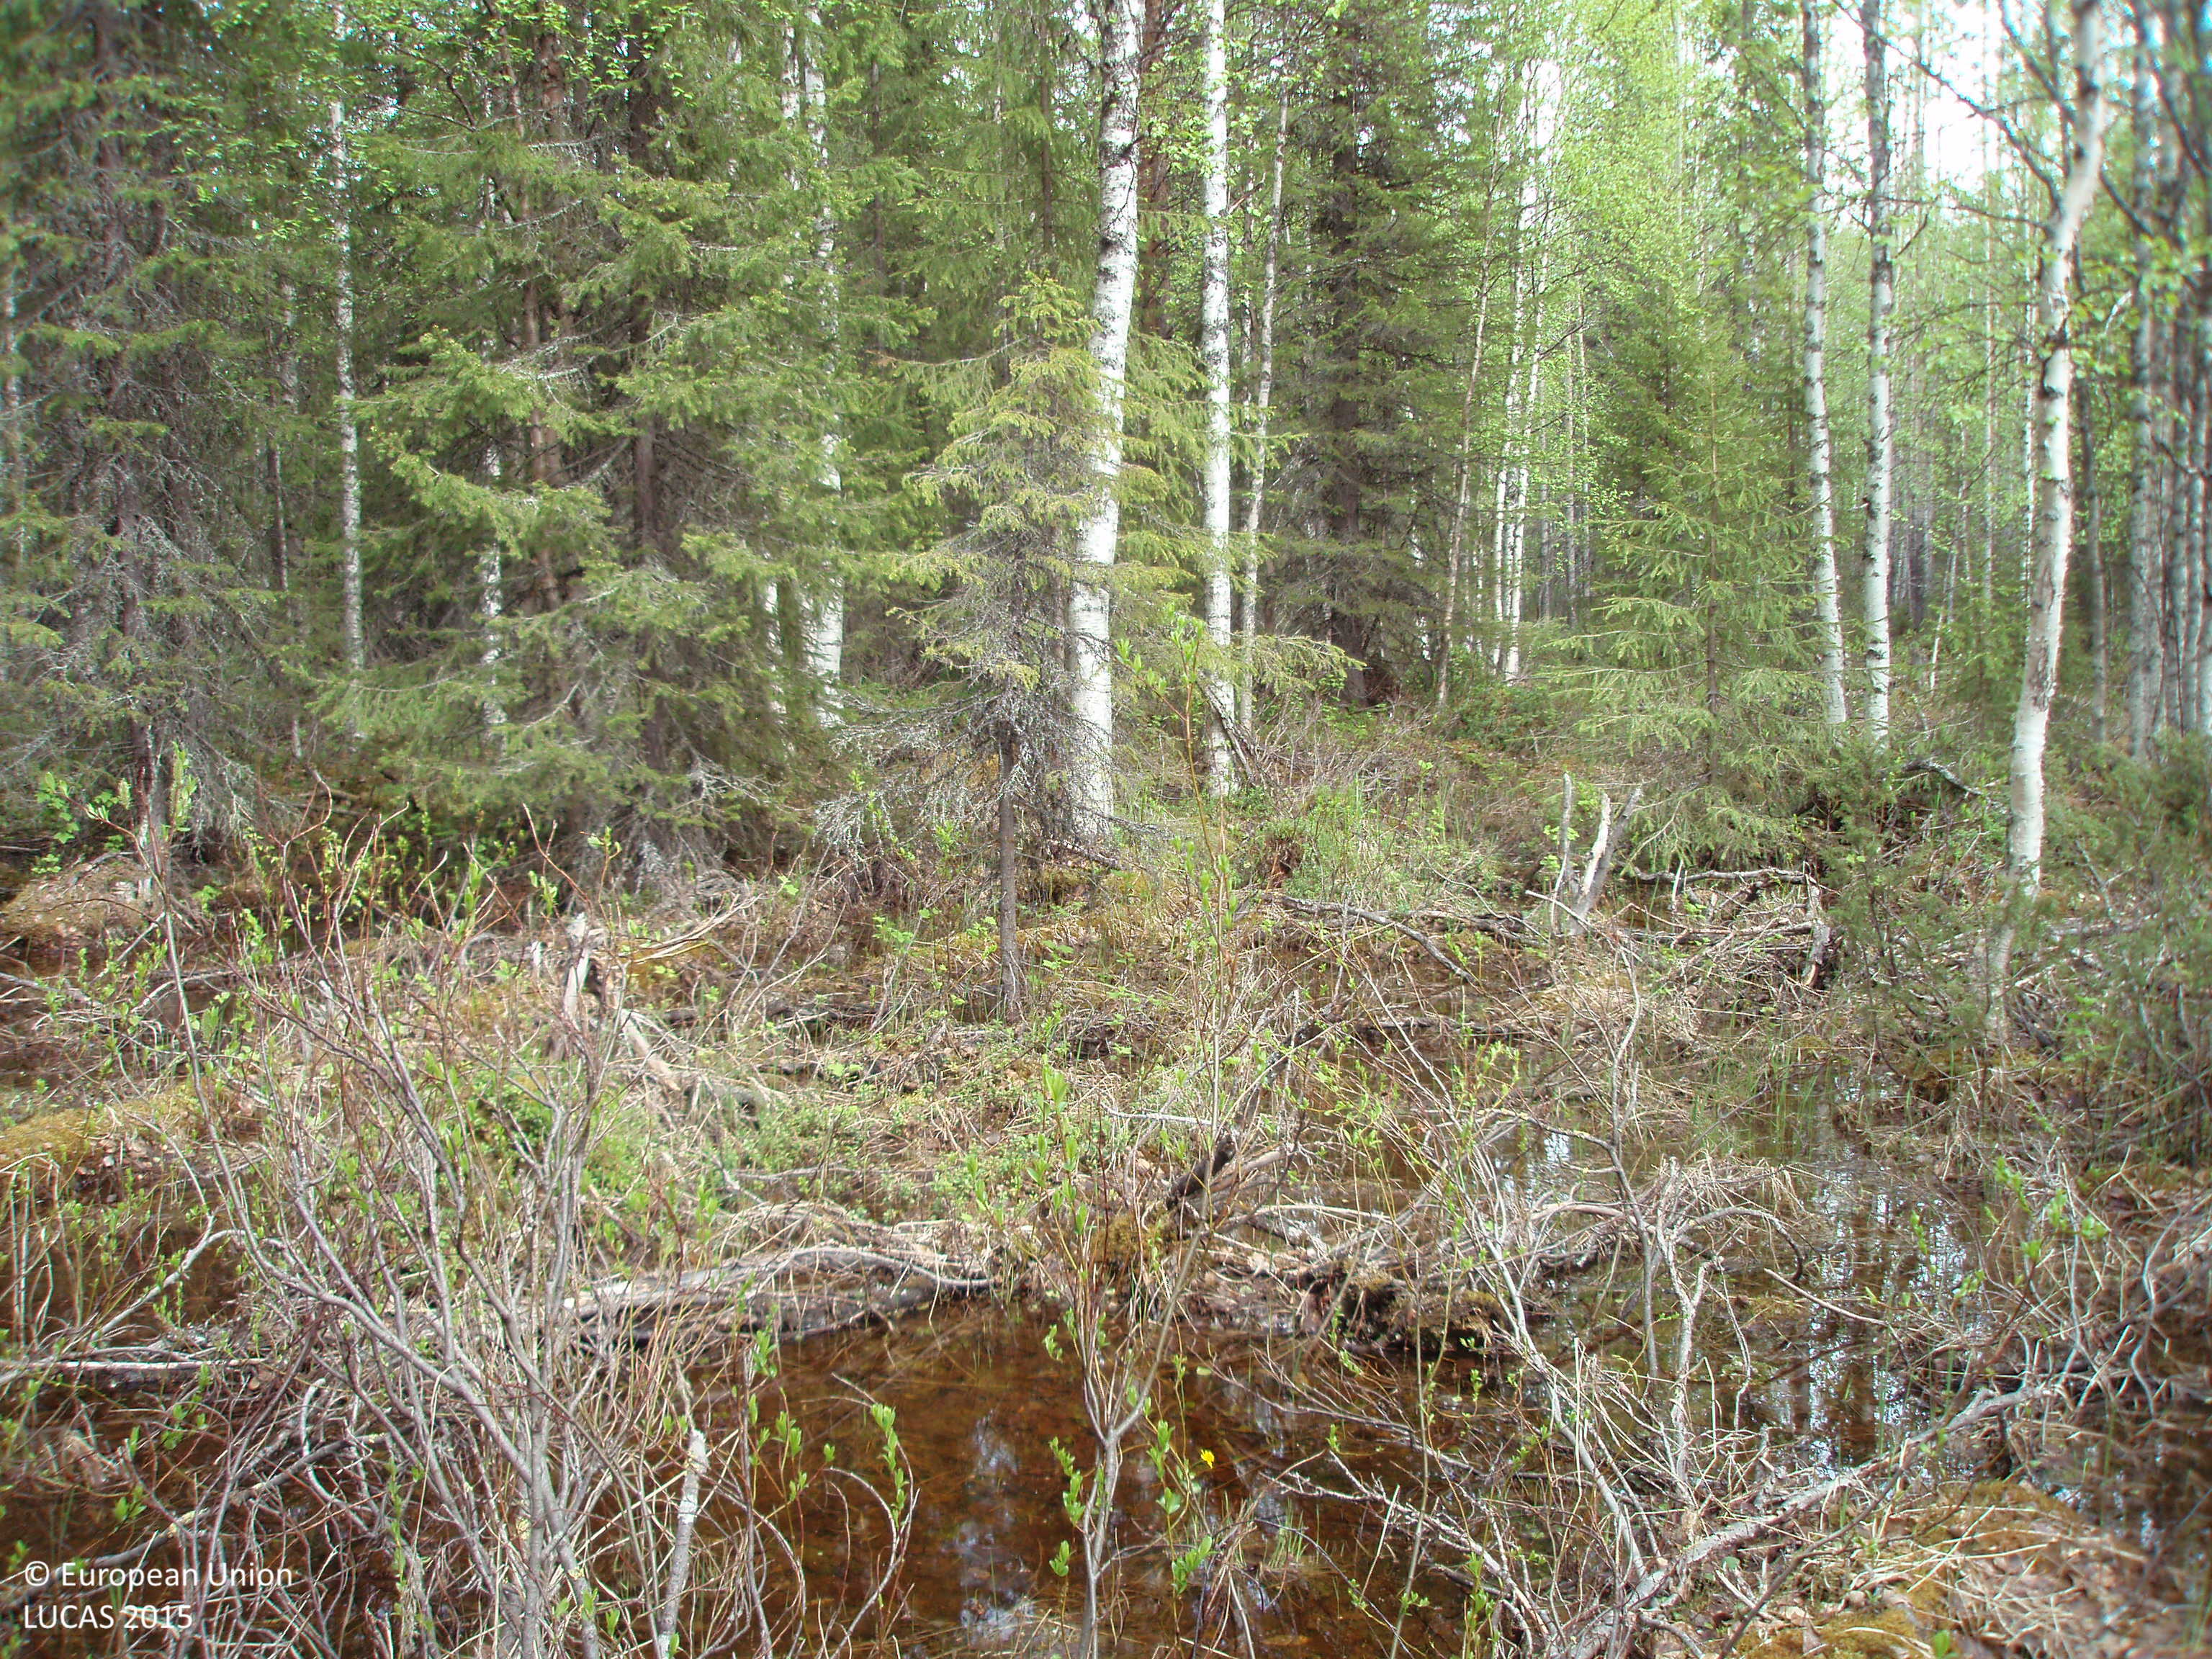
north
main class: Woodland
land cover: Other mixed woodland
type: boreal forest
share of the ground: > 75 %
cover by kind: coniferous forest trees 40 %, broadleaved forest trees 40 %, shrubs 10 %, herbaceous plants 10 %
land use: Forestry
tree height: > 5 m
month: June
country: FI
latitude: 67.1809
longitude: 26.9320
